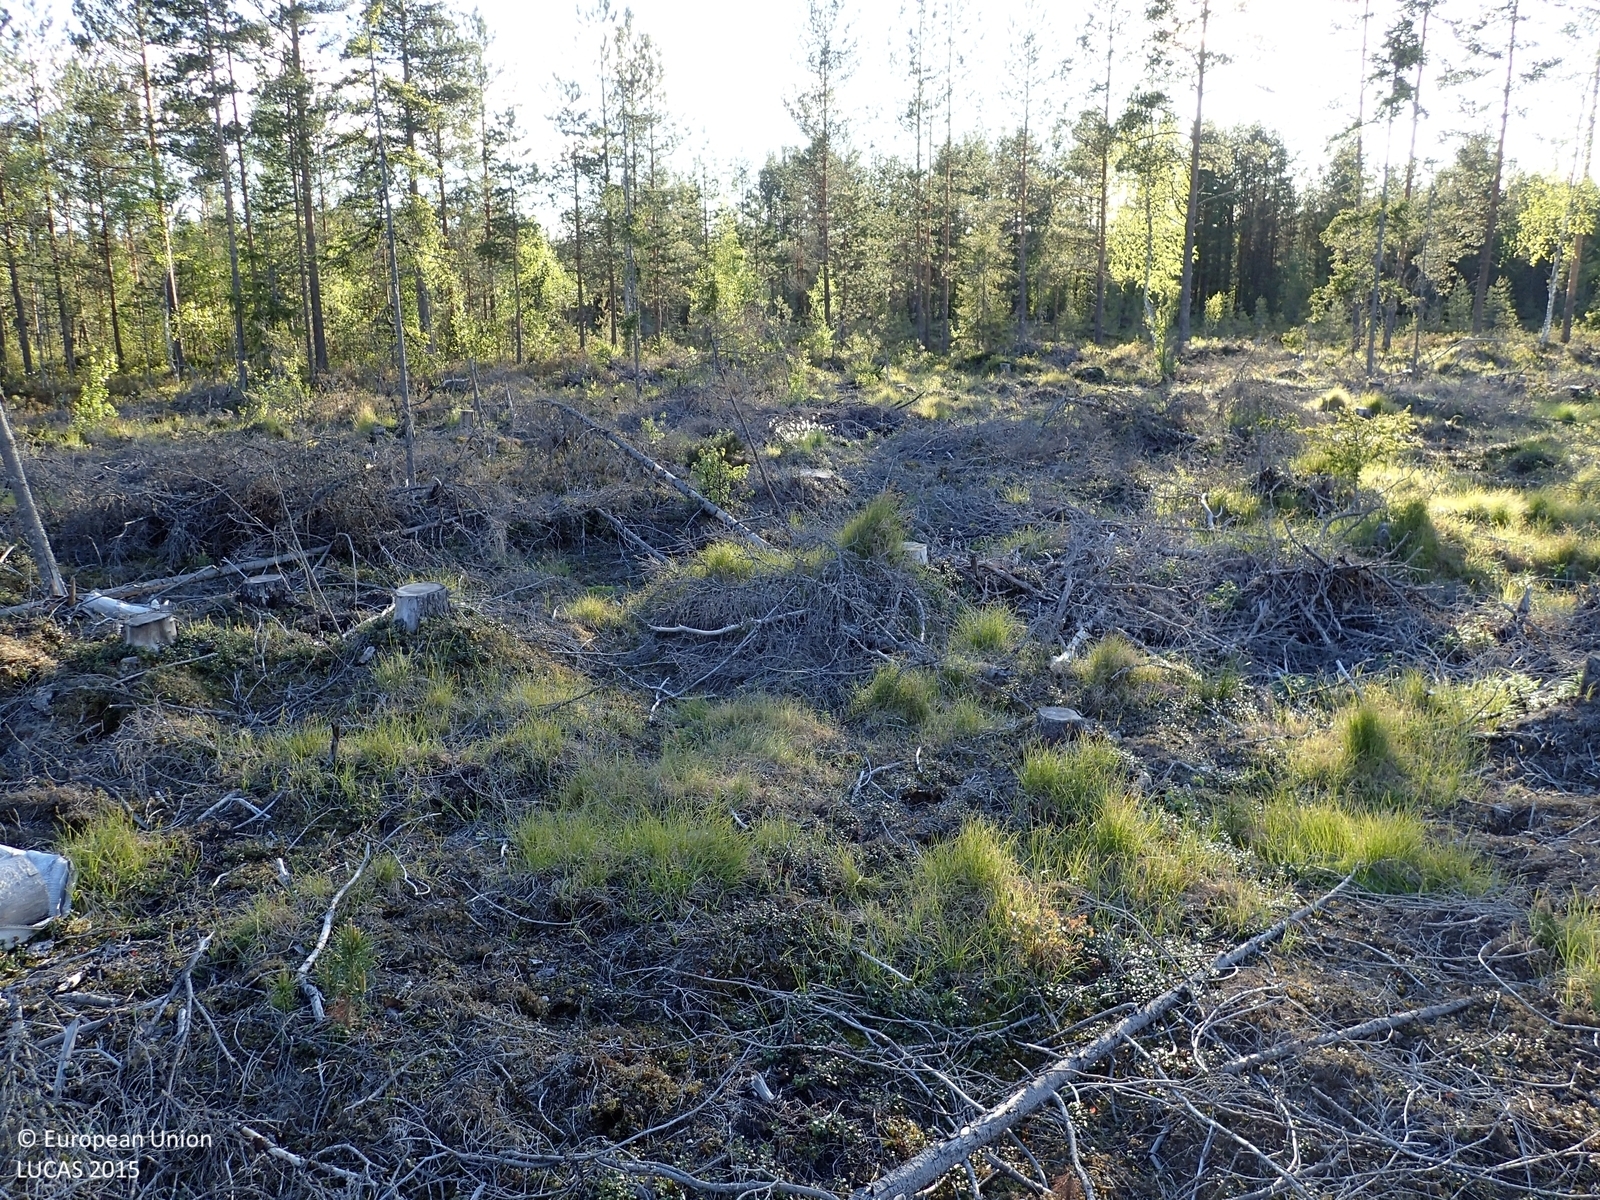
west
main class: Grassland
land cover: Grassland with sparse tree/shrub cover
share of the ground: 25 - 50 %
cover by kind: lichens and mosses 55 %, herbaceous plants 25 %, coniferous forest trees 5 %, shrubs 5 %, unconsolidated bare surface 5 %
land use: Forestry
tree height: < 5 m
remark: Clear cut
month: June
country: FI
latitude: 62.1990
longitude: 21.8308
